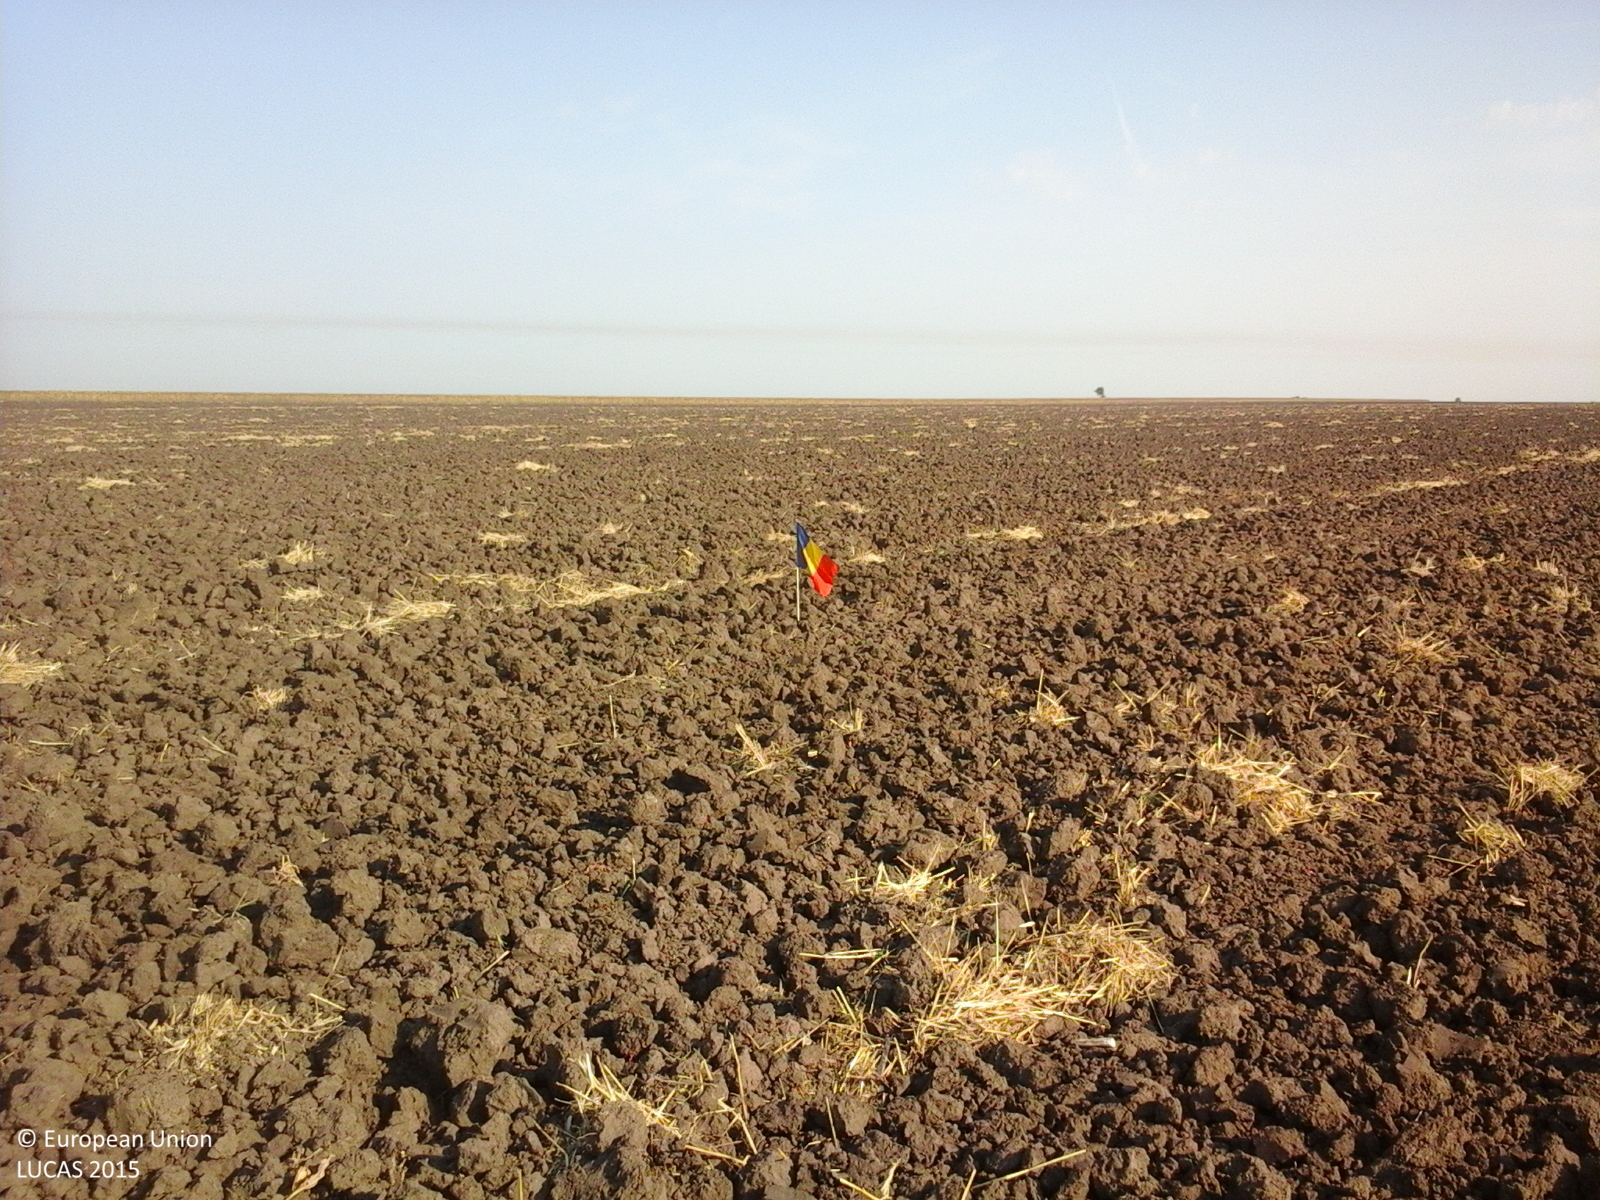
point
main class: Cropland
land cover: Common wheat
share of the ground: < 10 %
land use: Agriculture (excluding fallow land and kitchen gardens)
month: August
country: RO
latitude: 43.9990
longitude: 23.7332
